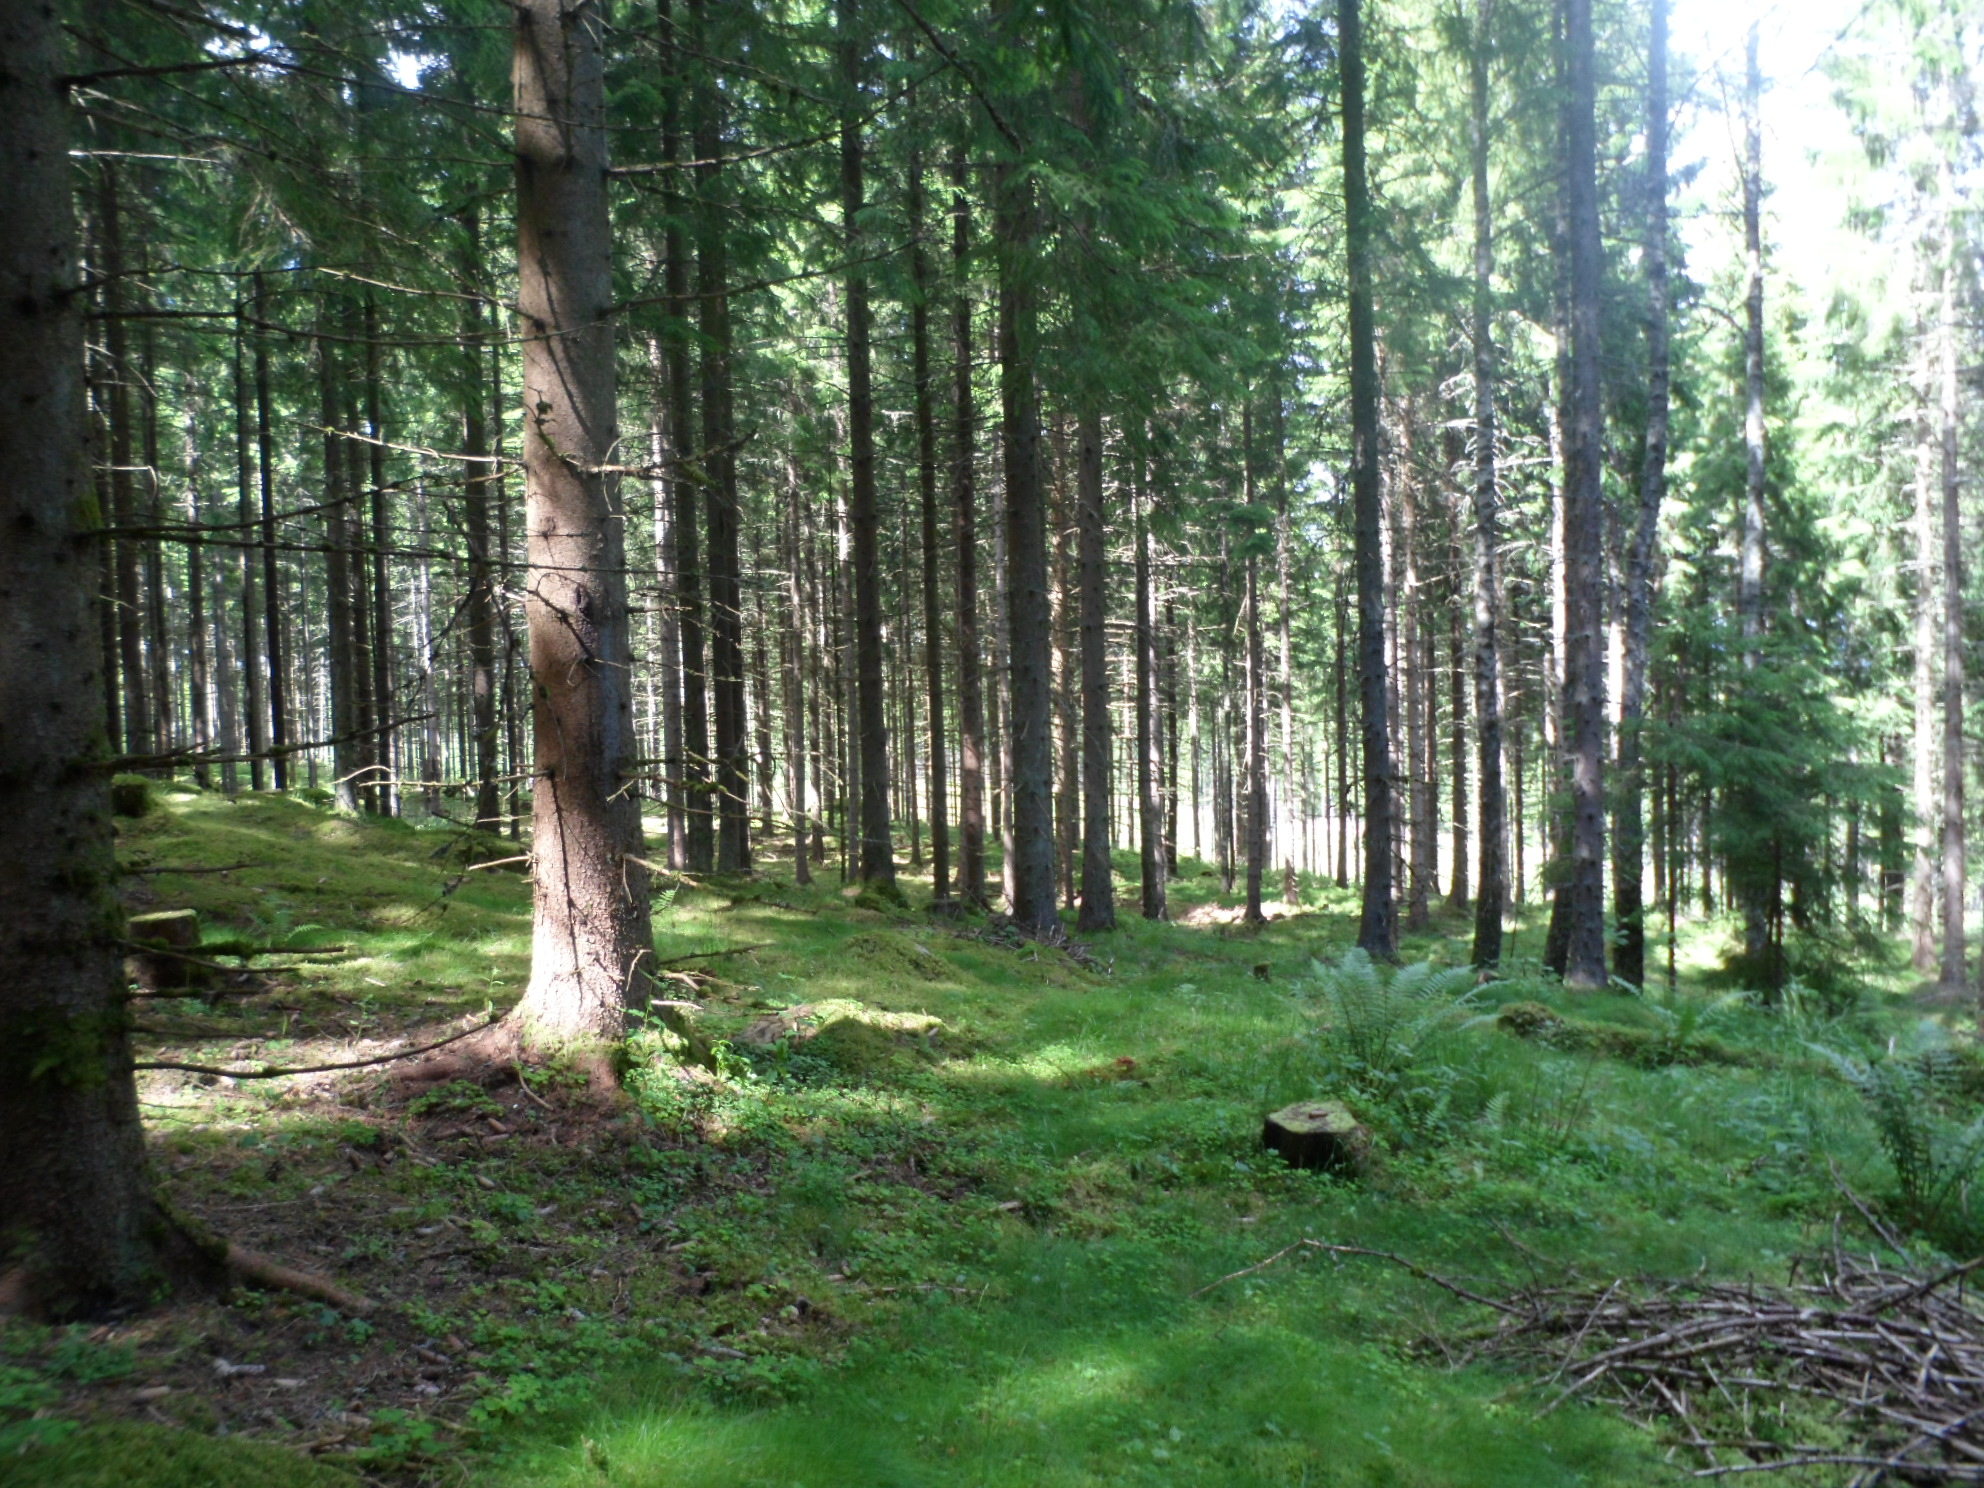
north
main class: Woodland
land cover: Spruce dominated coniferous woodland
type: boreal forest
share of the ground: > 75 %
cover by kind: coniferous forest trees 75 %, lichens and mosses 15 %, shrubs 5 %, herbaceous plants 5 %
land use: Forestry
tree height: > 5 m
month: June
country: SE
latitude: 57.1438
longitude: 14.7728
